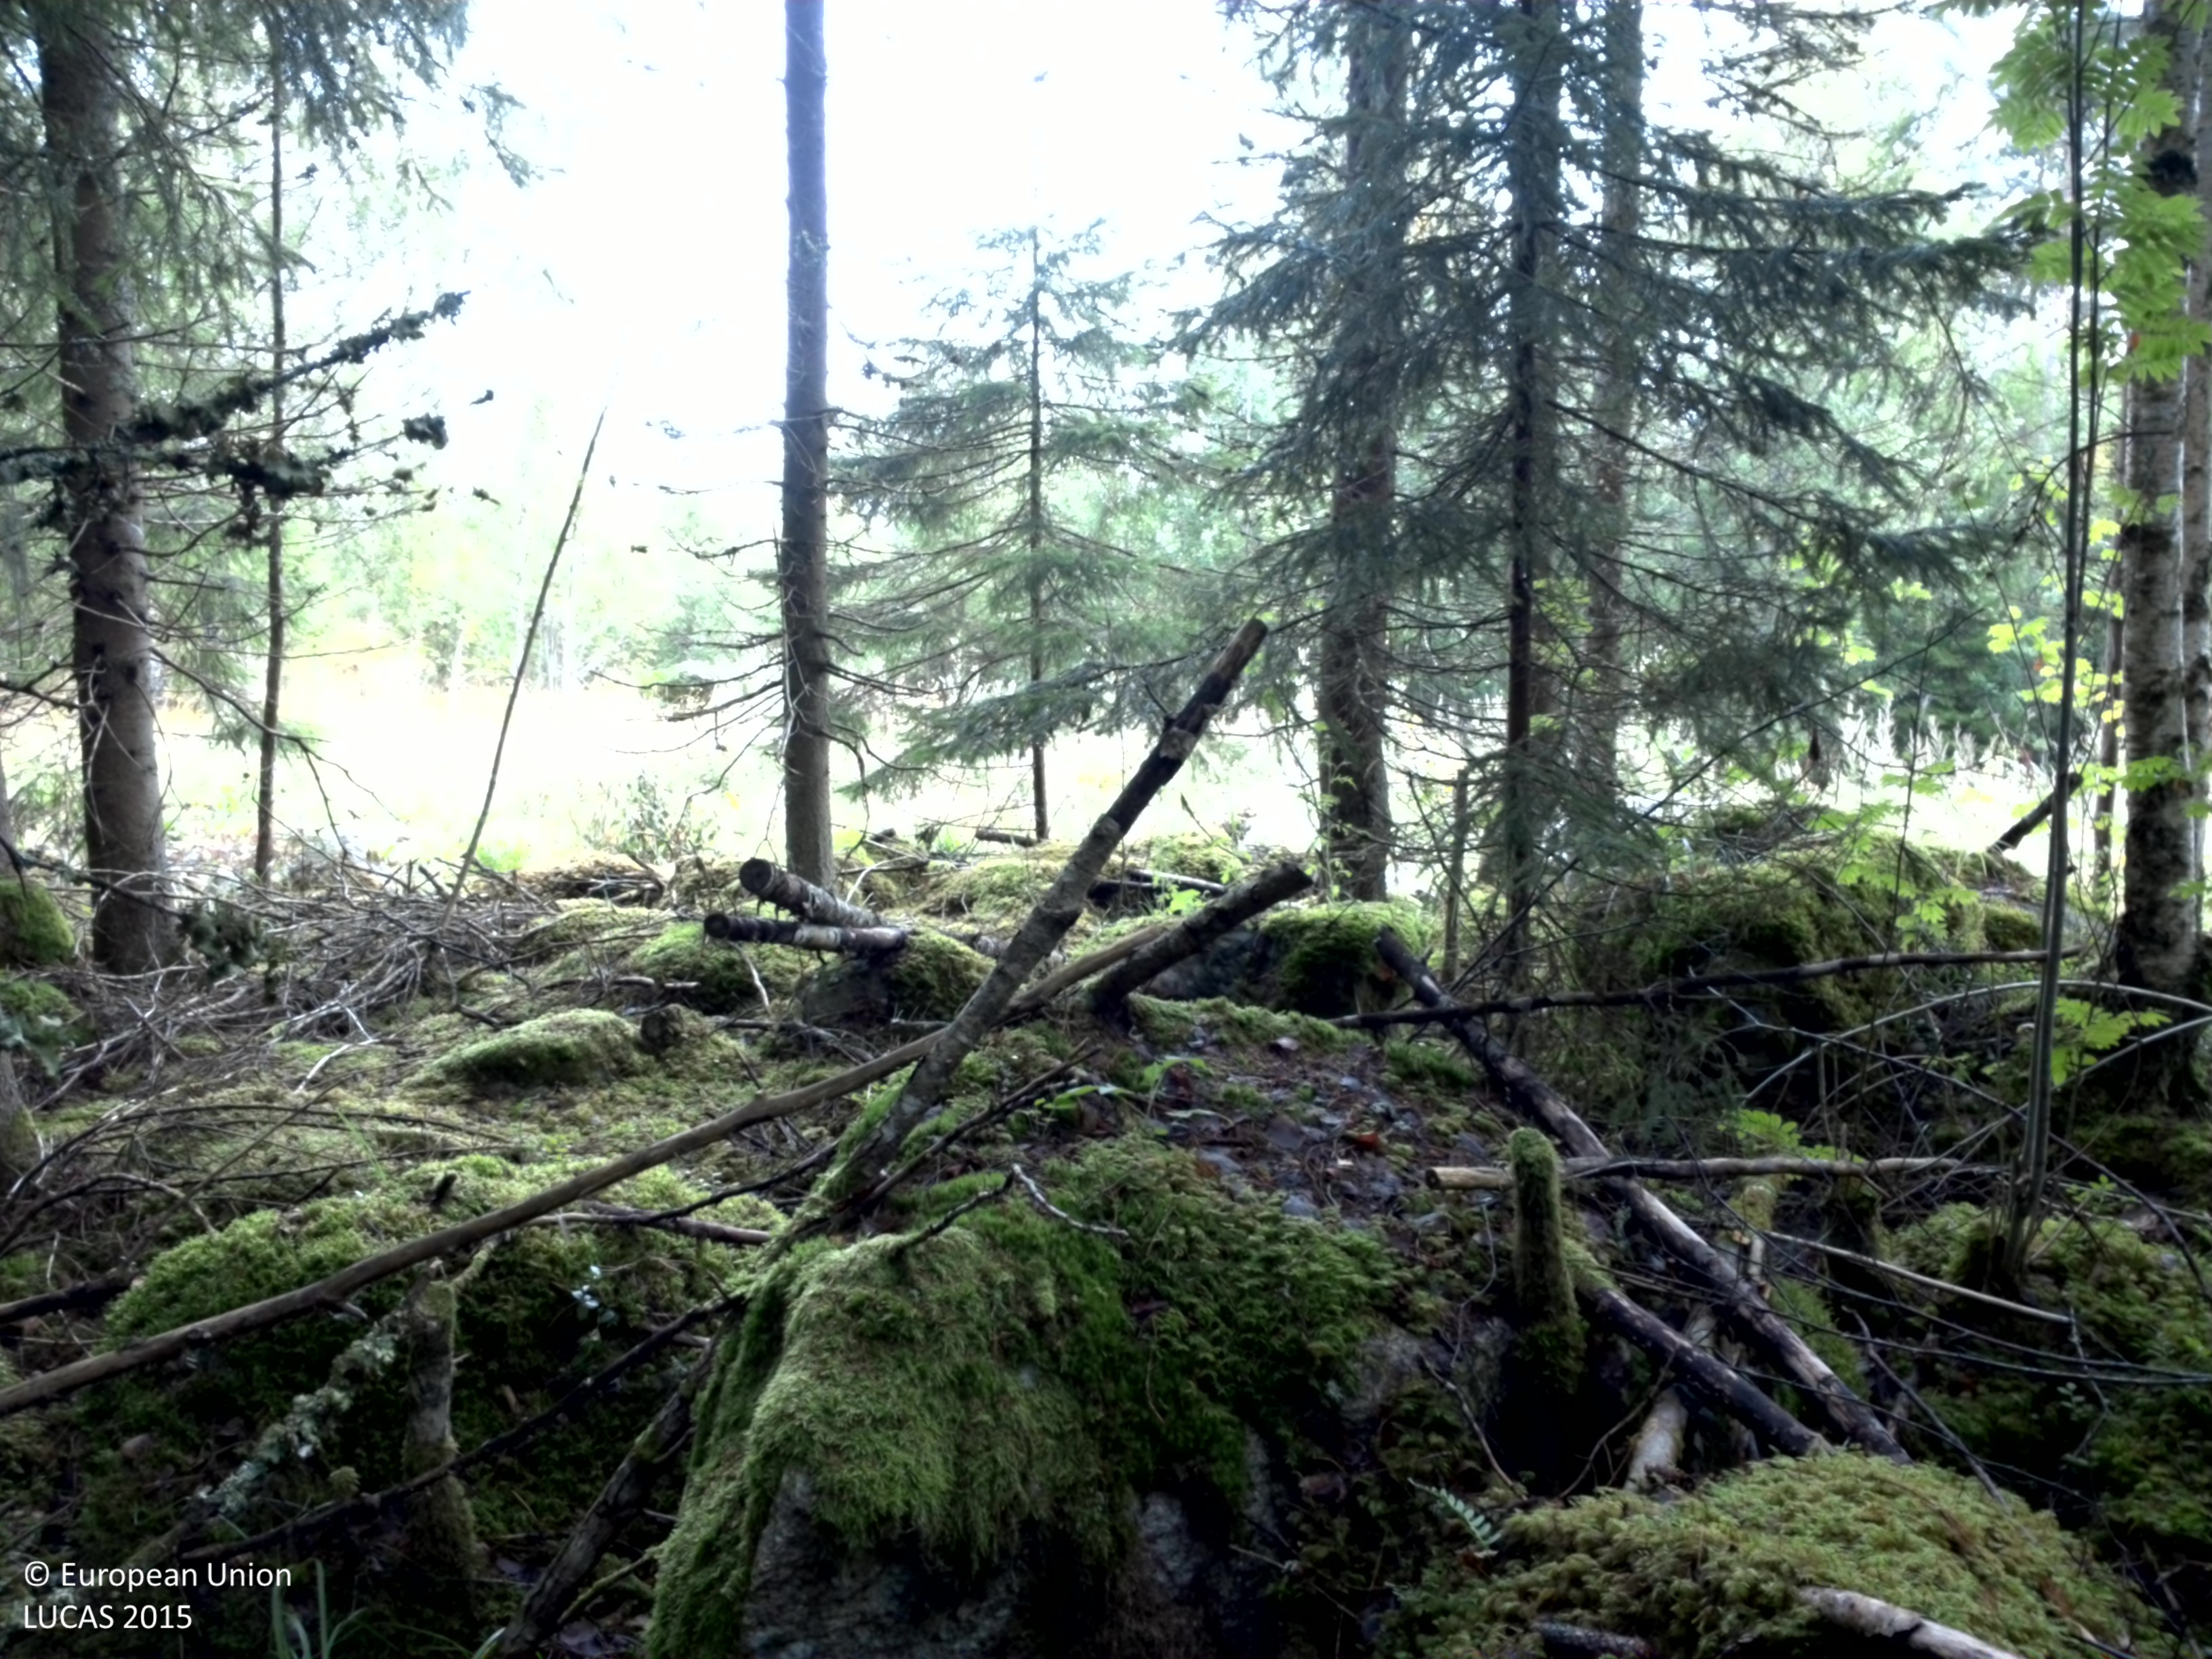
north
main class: Woodland
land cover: Spruce dominated coniferous woodland
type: boreal forest
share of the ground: > 75 %
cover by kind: coniferous forest trees 80 %, broadleaved forest trees 10 %, lichens and mosses 10 %
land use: Forestry
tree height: > 5 m
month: August
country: SE
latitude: 59.9231
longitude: 16.4844
